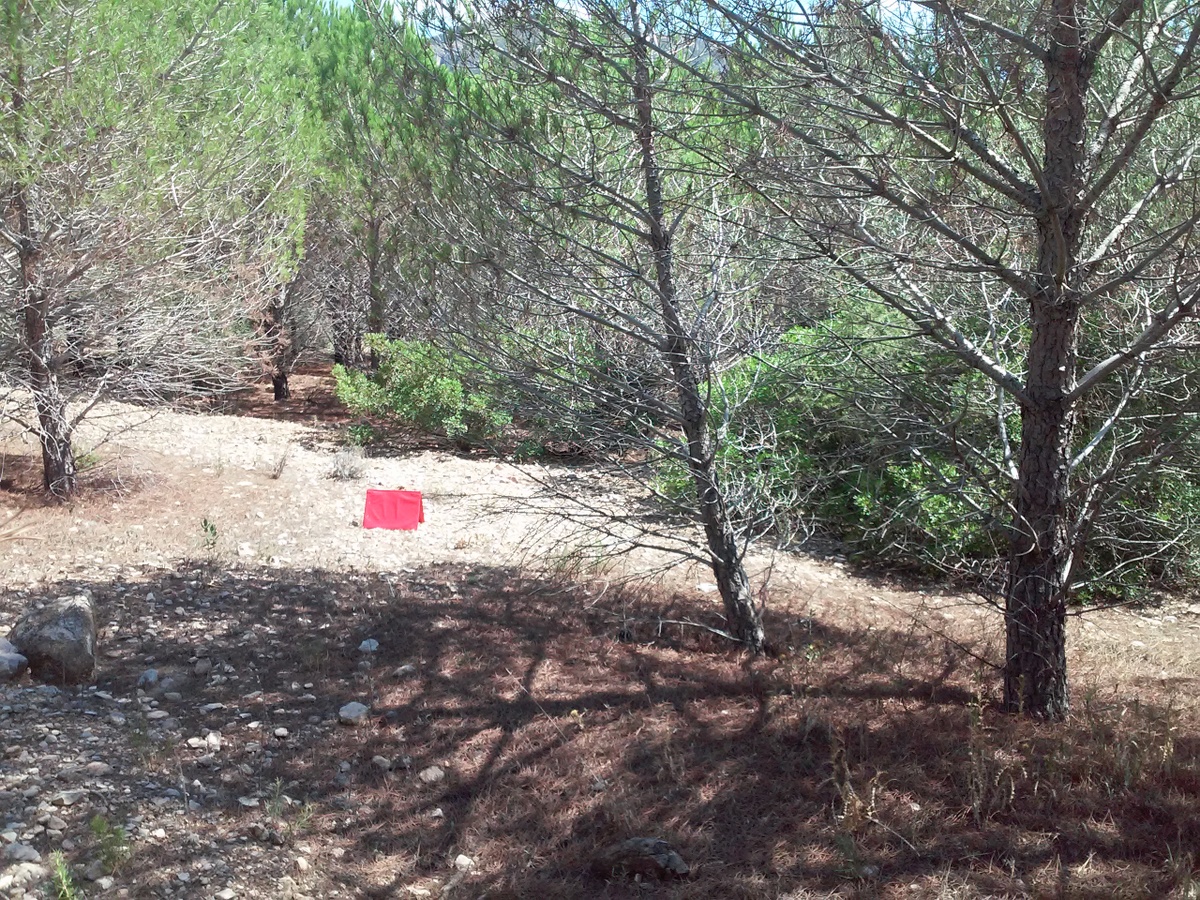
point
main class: Woodland
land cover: Pine dominated coniferous woodland
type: coniferous forest of the mediterranean region
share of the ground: 25 - 50 %
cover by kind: coniferous forest trees 50 %, shrubs 50 %
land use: Semi-natural and natural areas not in use
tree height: < 5 m
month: August
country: ES
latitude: 41.0059
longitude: 0.6833
